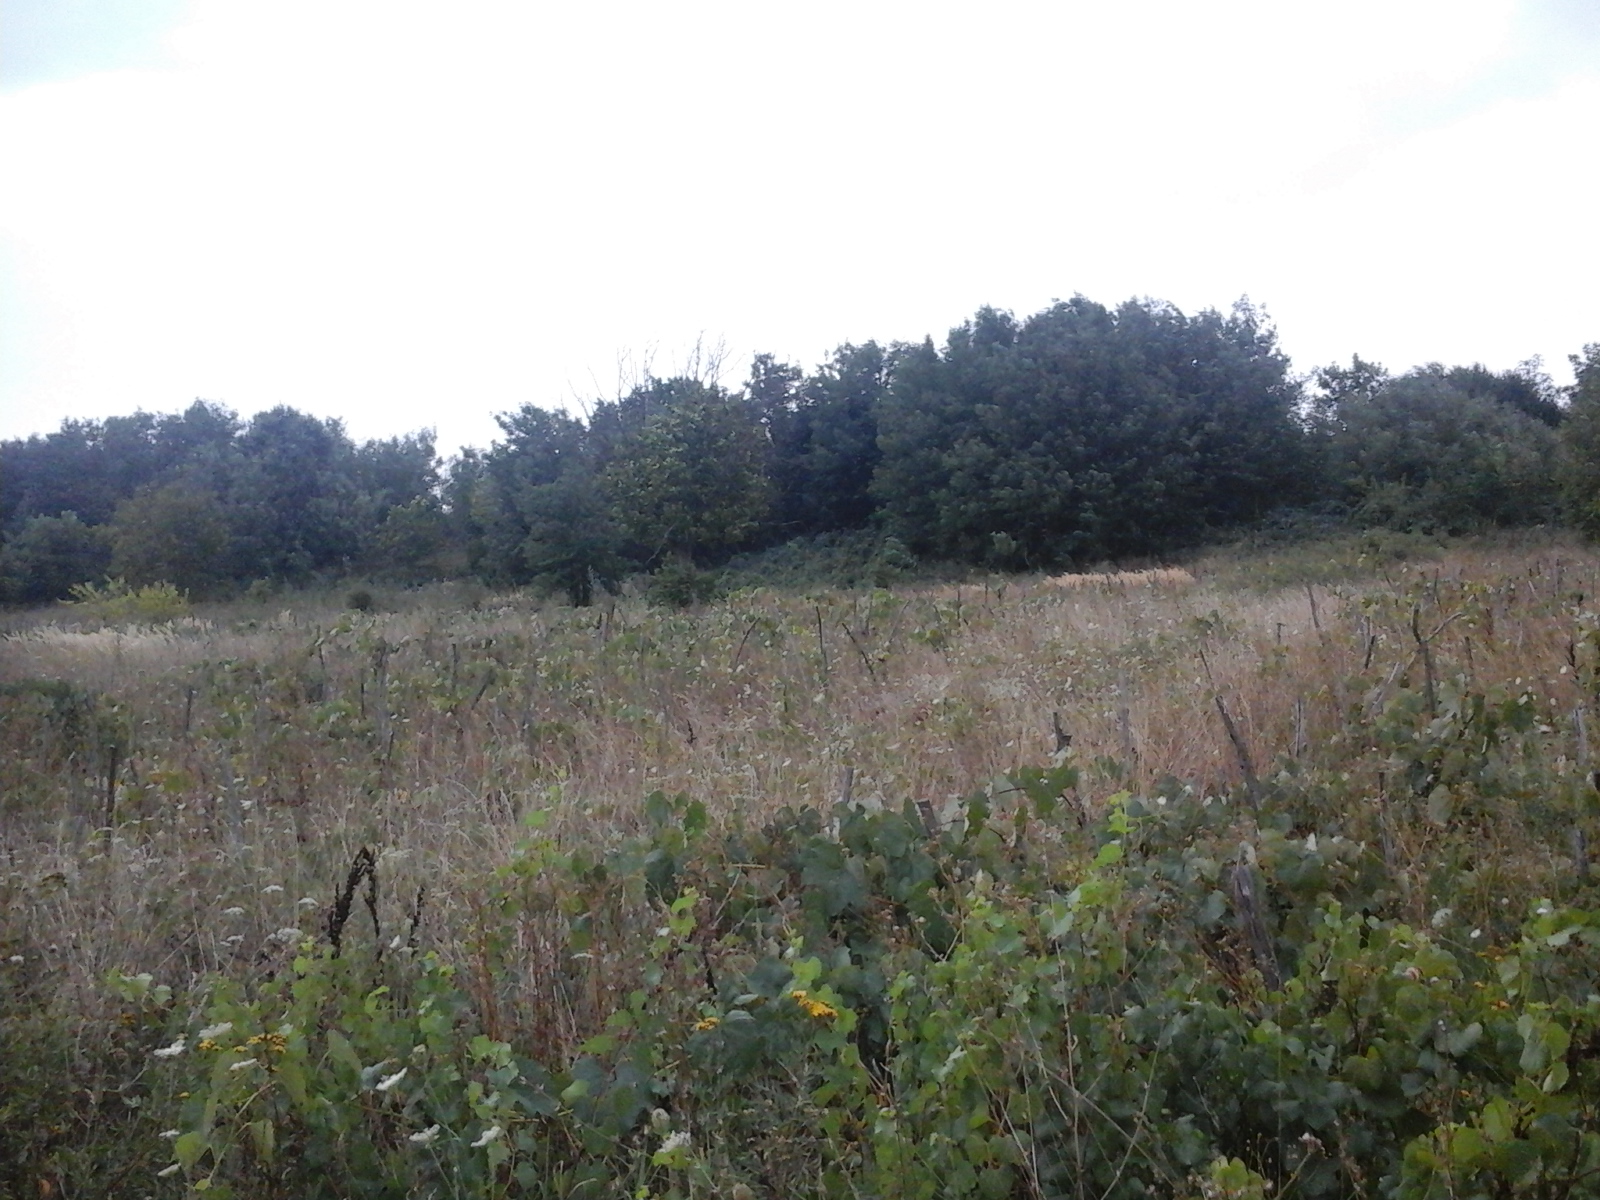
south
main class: Grassland
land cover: Grassland without tree/shrub cover
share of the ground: > 75 %
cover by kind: herbaceous plants 100 %
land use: Agriculture (excluding fallow land and kitchen gardens)
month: August
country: RO
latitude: 44.3327
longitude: 23.2793
